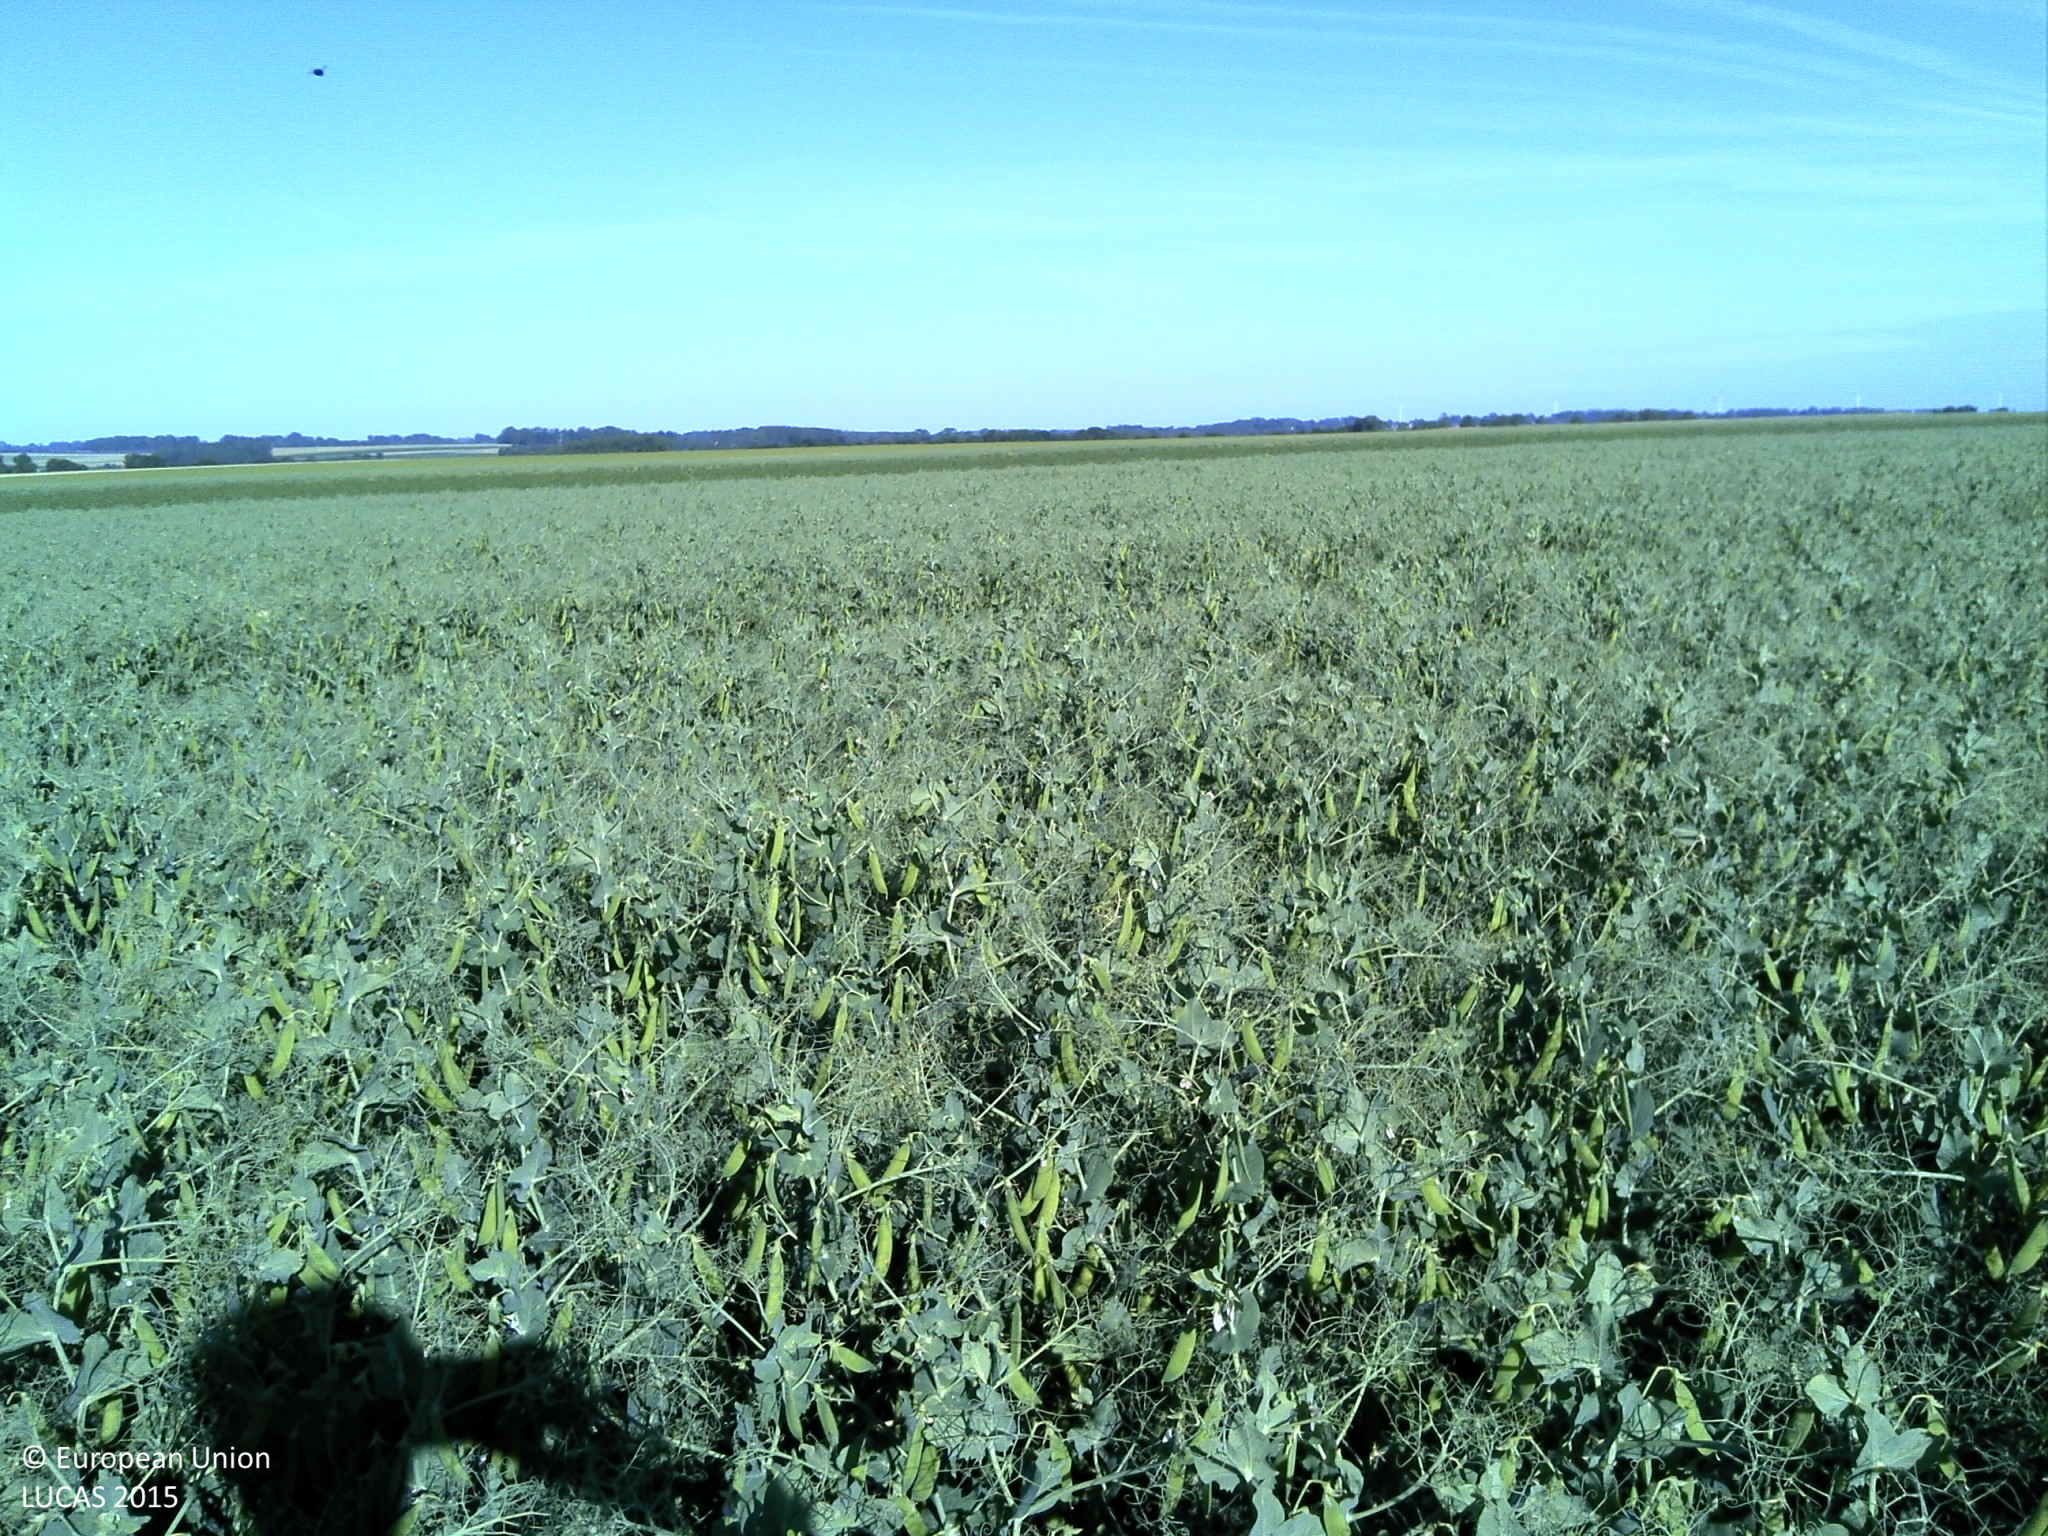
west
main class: Cropland
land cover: Dry pulses
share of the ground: > 75 %
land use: Agriculture (excluding fallow land and kitchen gardens)
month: June
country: FR
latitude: 49.7751
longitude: 1.0209
